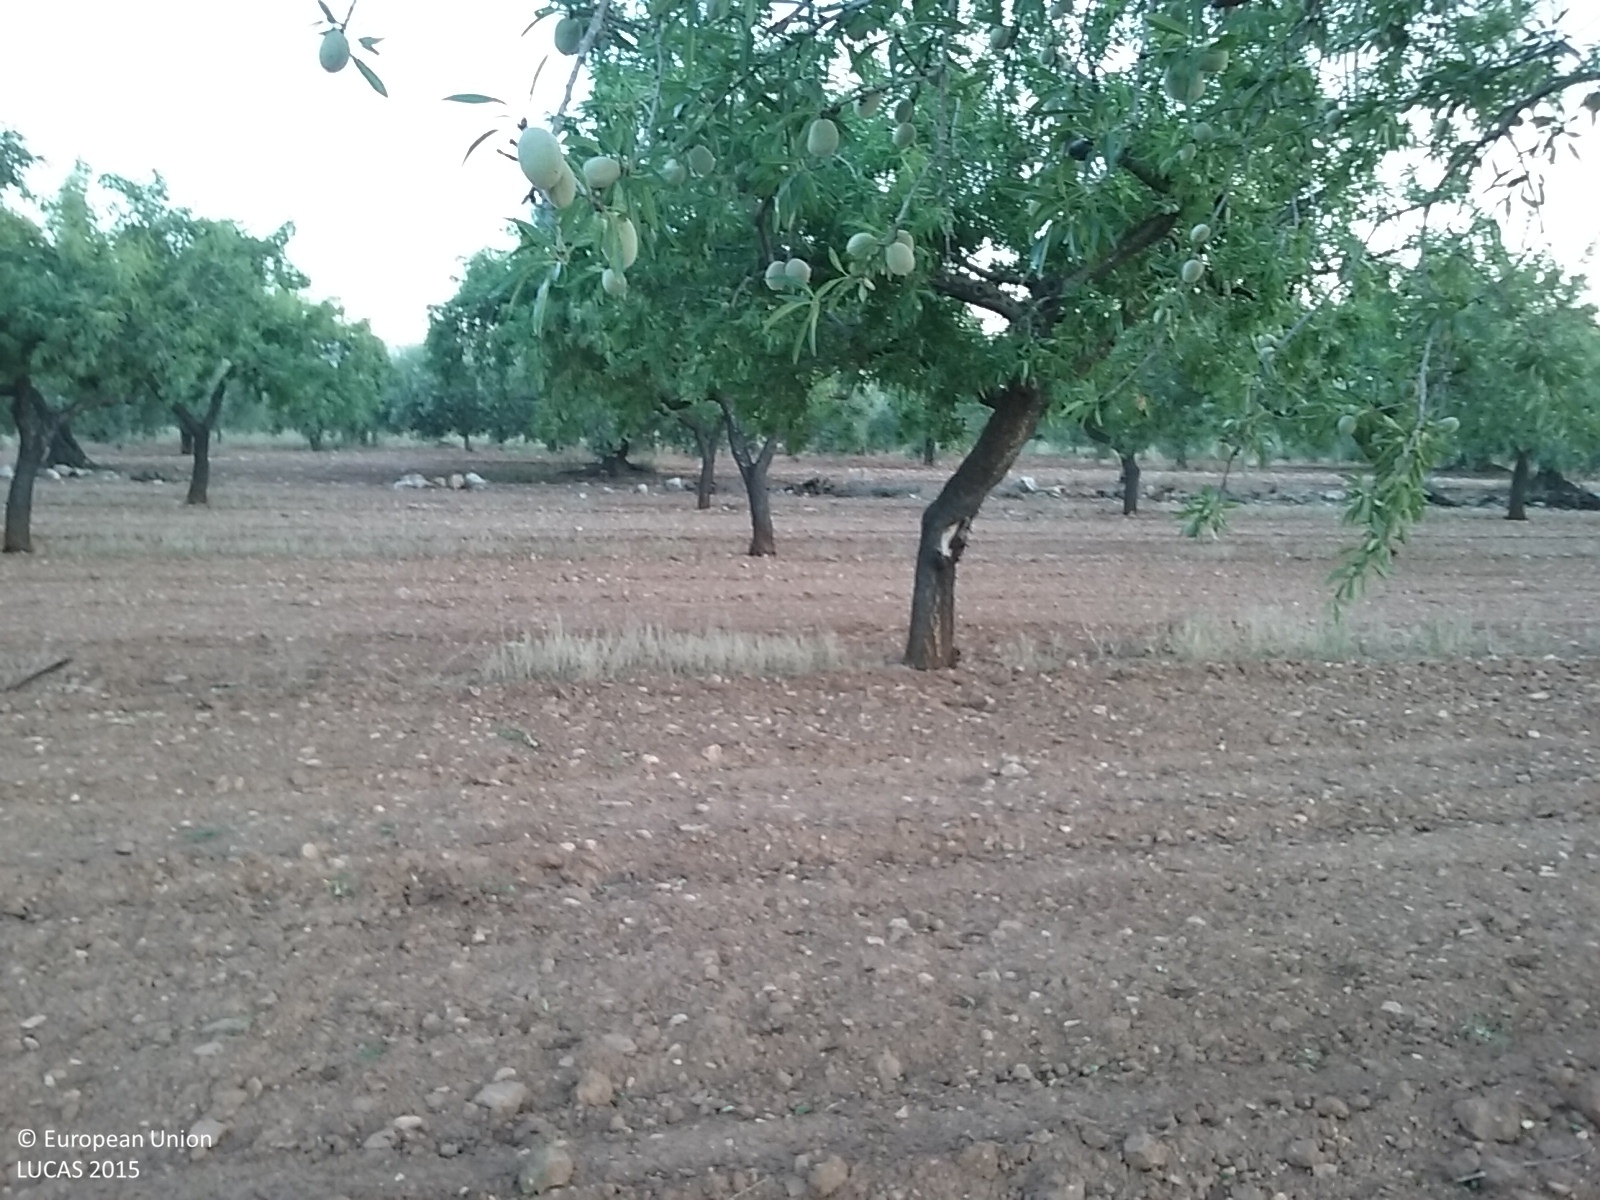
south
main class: Cropland
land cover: Nuts trees
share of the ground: 50 - 75 %
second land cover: Other bare soil
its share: > 75 %
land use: Agriculture (excluding fallow land and kitchen gardens)
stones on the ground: < 10 %
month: May
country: ES
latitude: 40.1853
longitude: -0.0686
